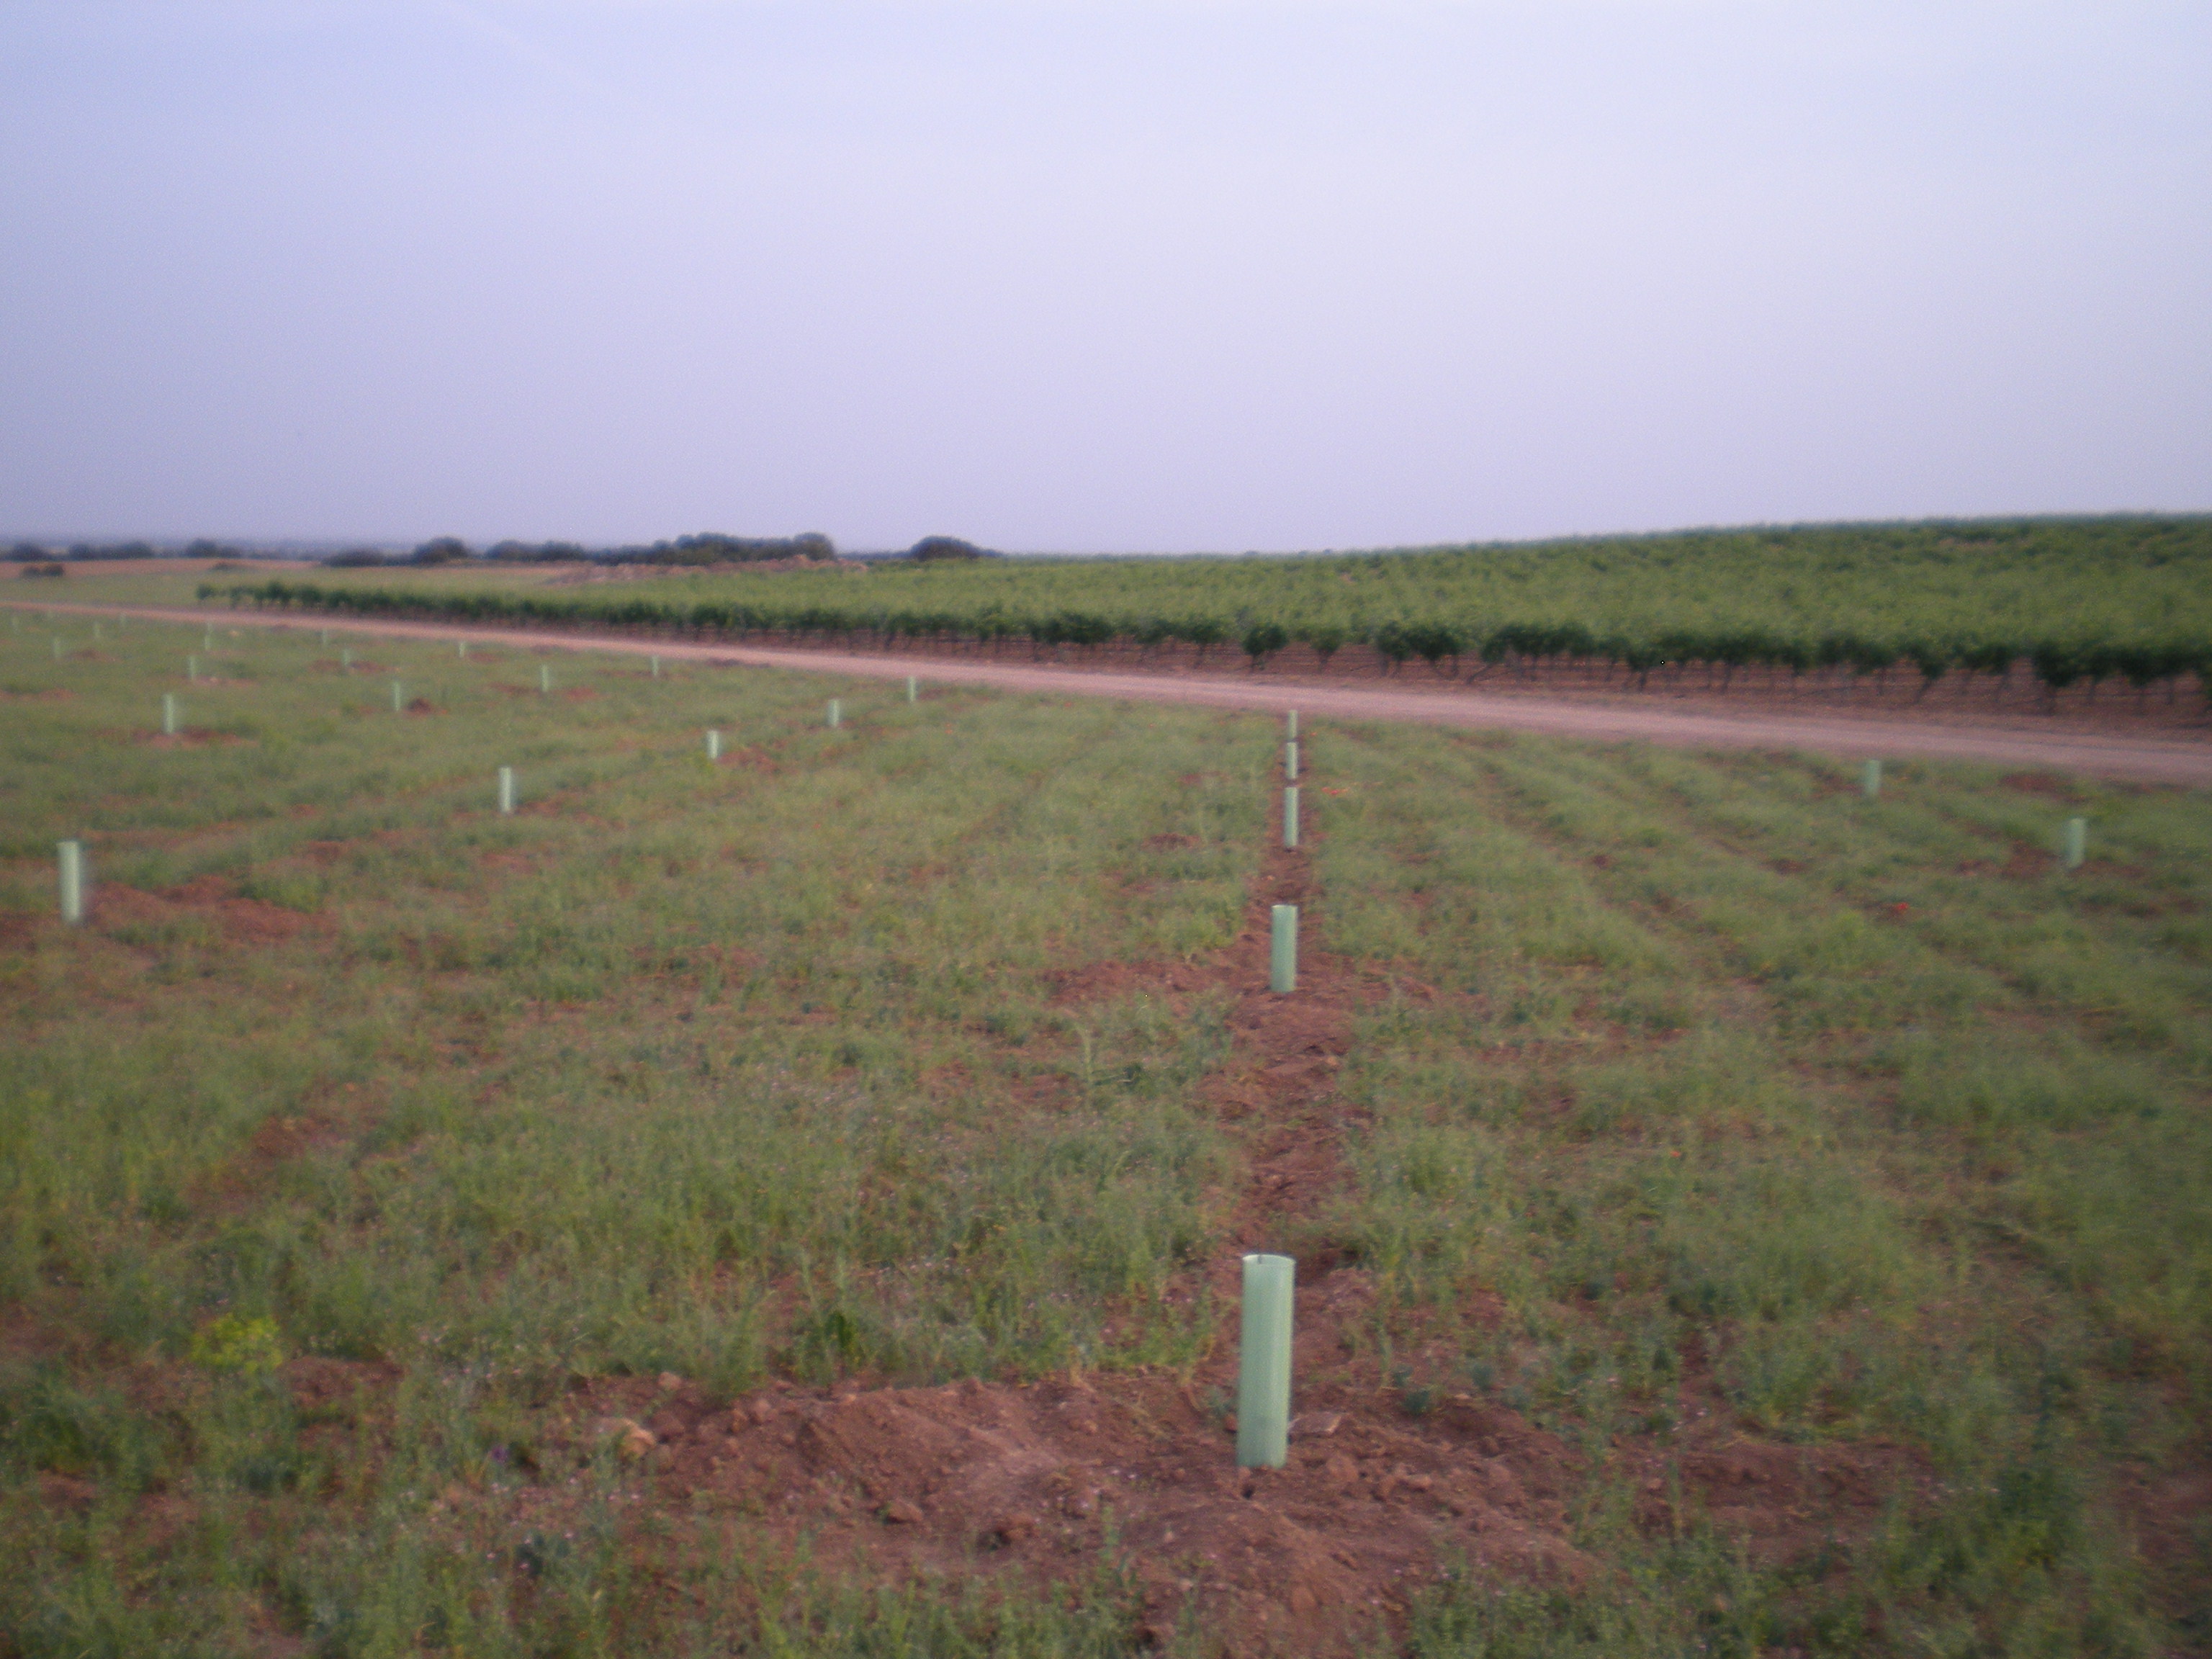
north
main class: Cropland
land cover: Nuts trees
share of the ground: < 10 %
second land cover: Spontaneously vegetated surfaces
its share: 50 - 75 %
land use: Agriculture (excluding fallow land and kitchen gardens)
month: May
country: ES
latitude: 39.0670
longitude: -3.0137
